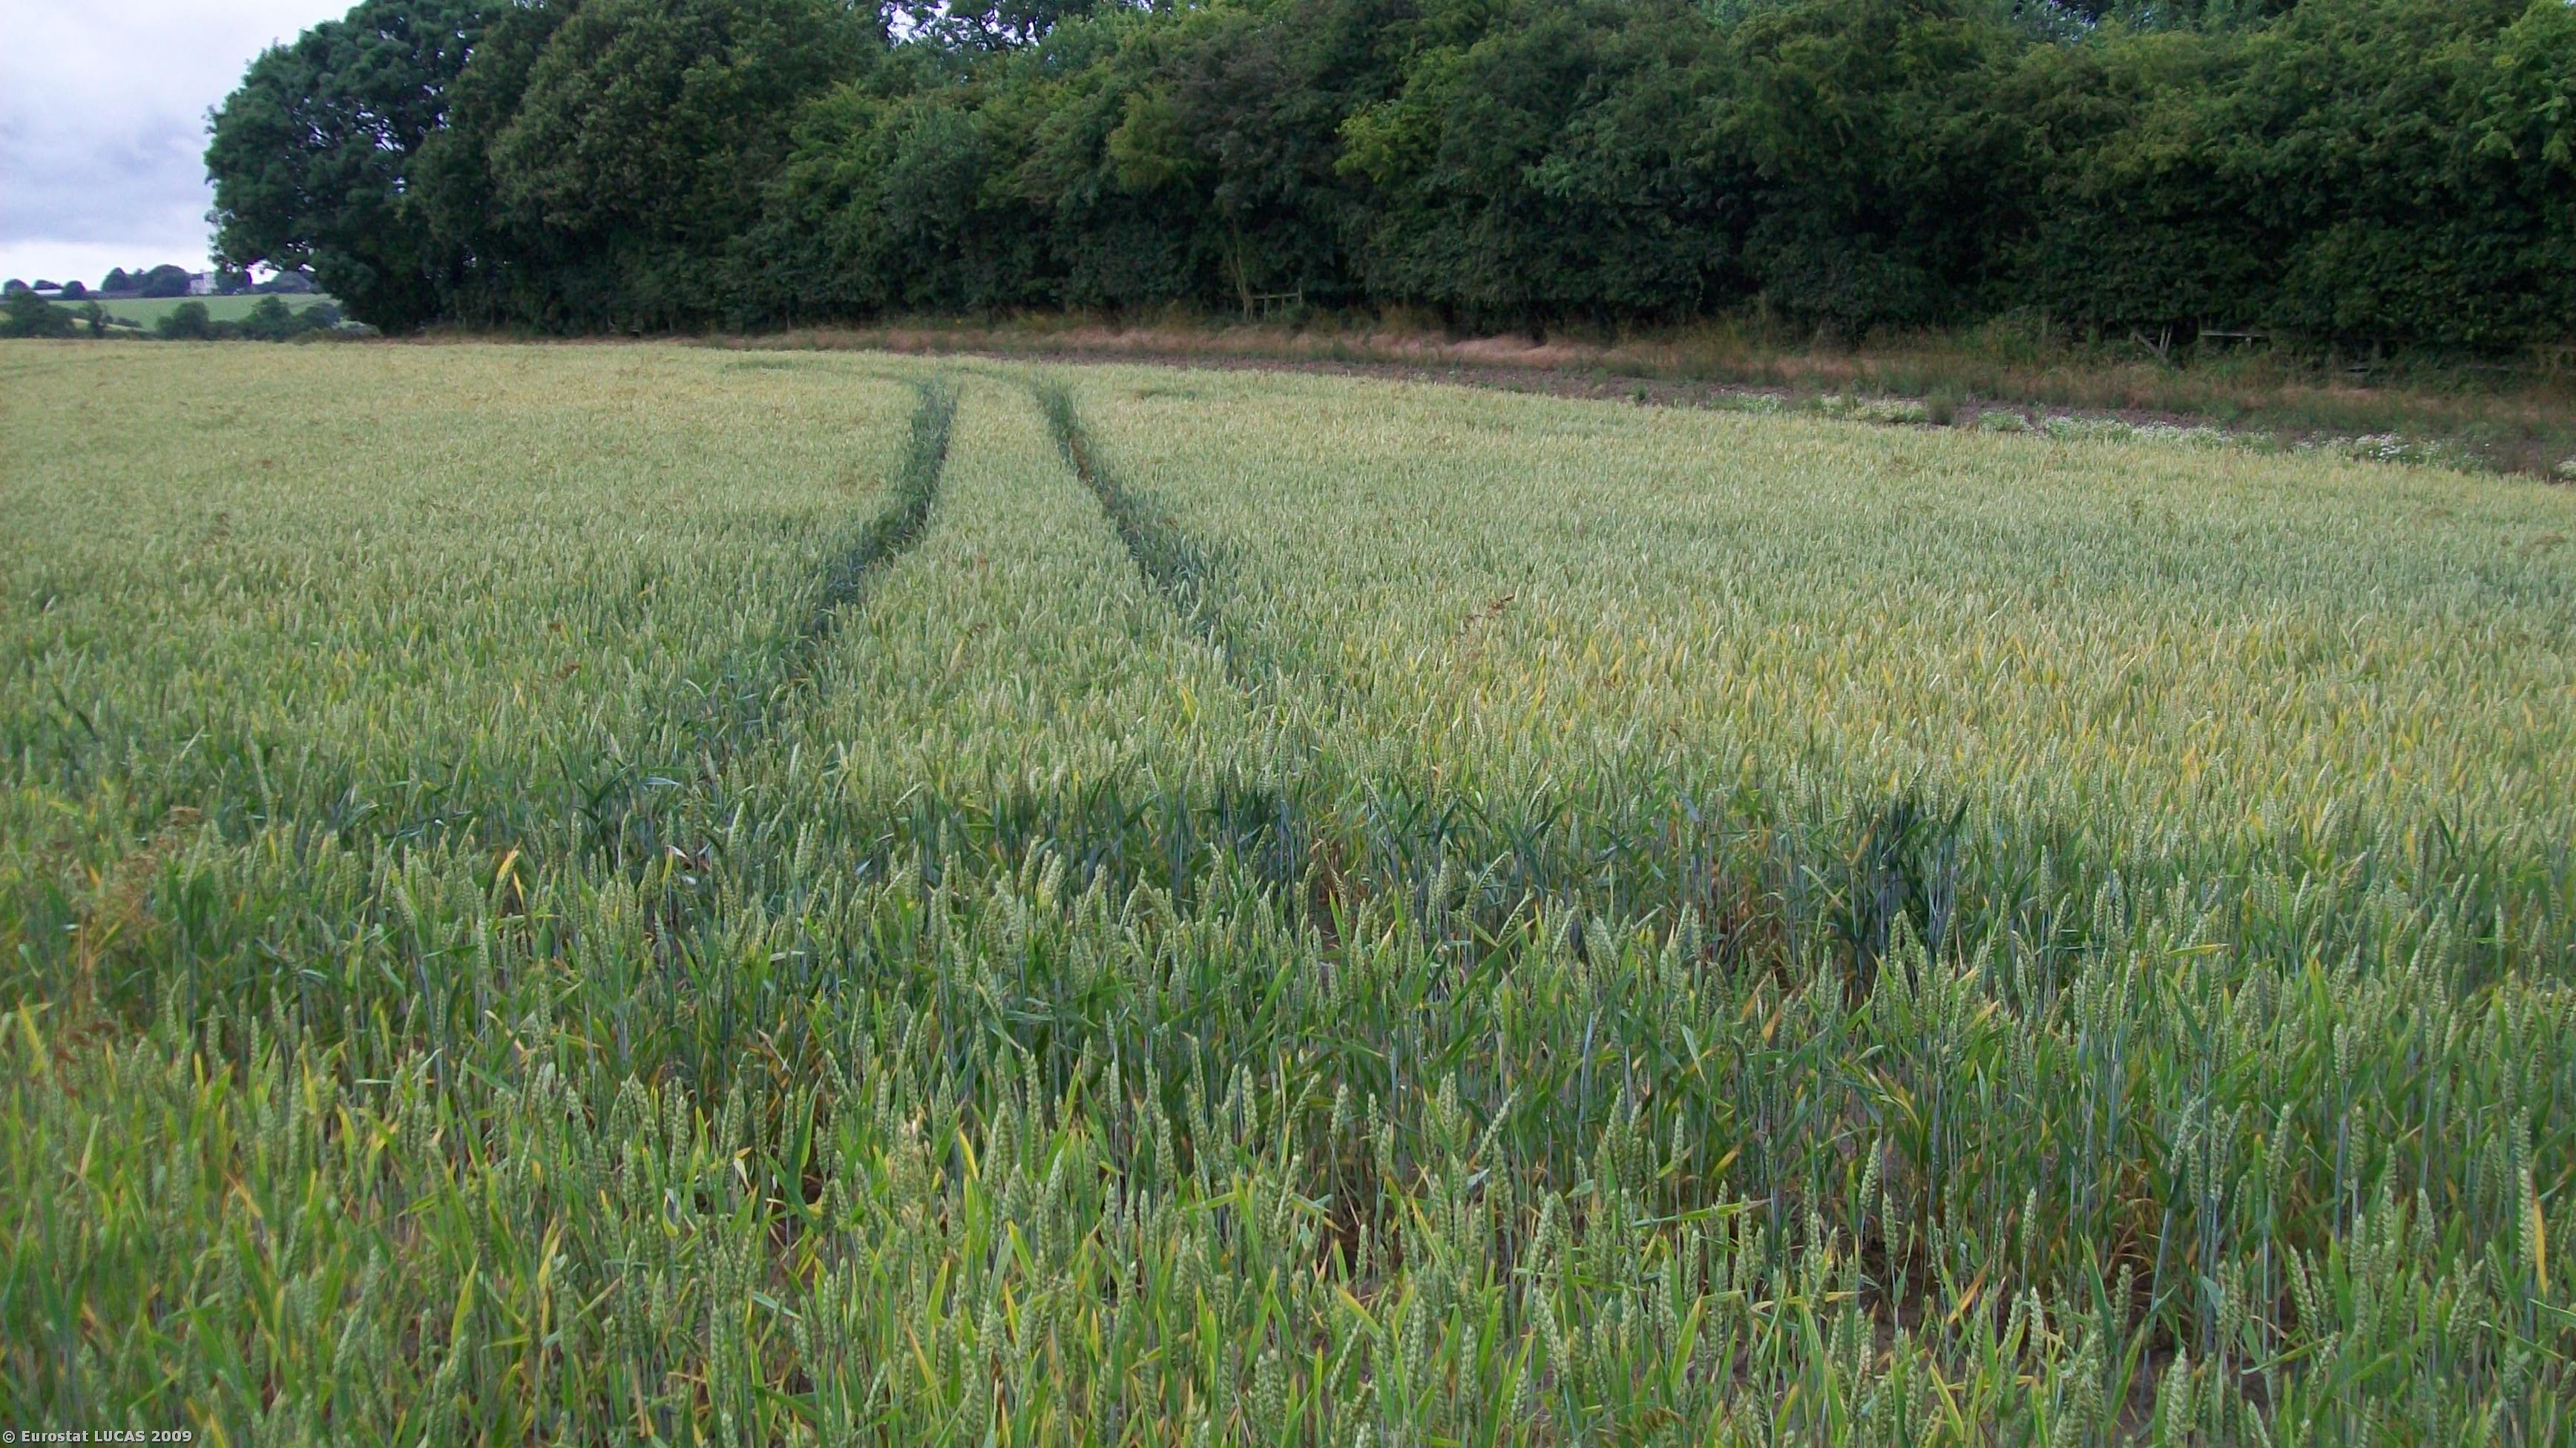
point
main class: Cropland
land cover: Common wheat
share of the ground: > 75 %
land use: Agriculture (excluding fallow land and kitchen gardens)
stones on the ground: 10 - 25 %
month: July
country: GB
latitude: 52.7662
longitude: -1.4470
